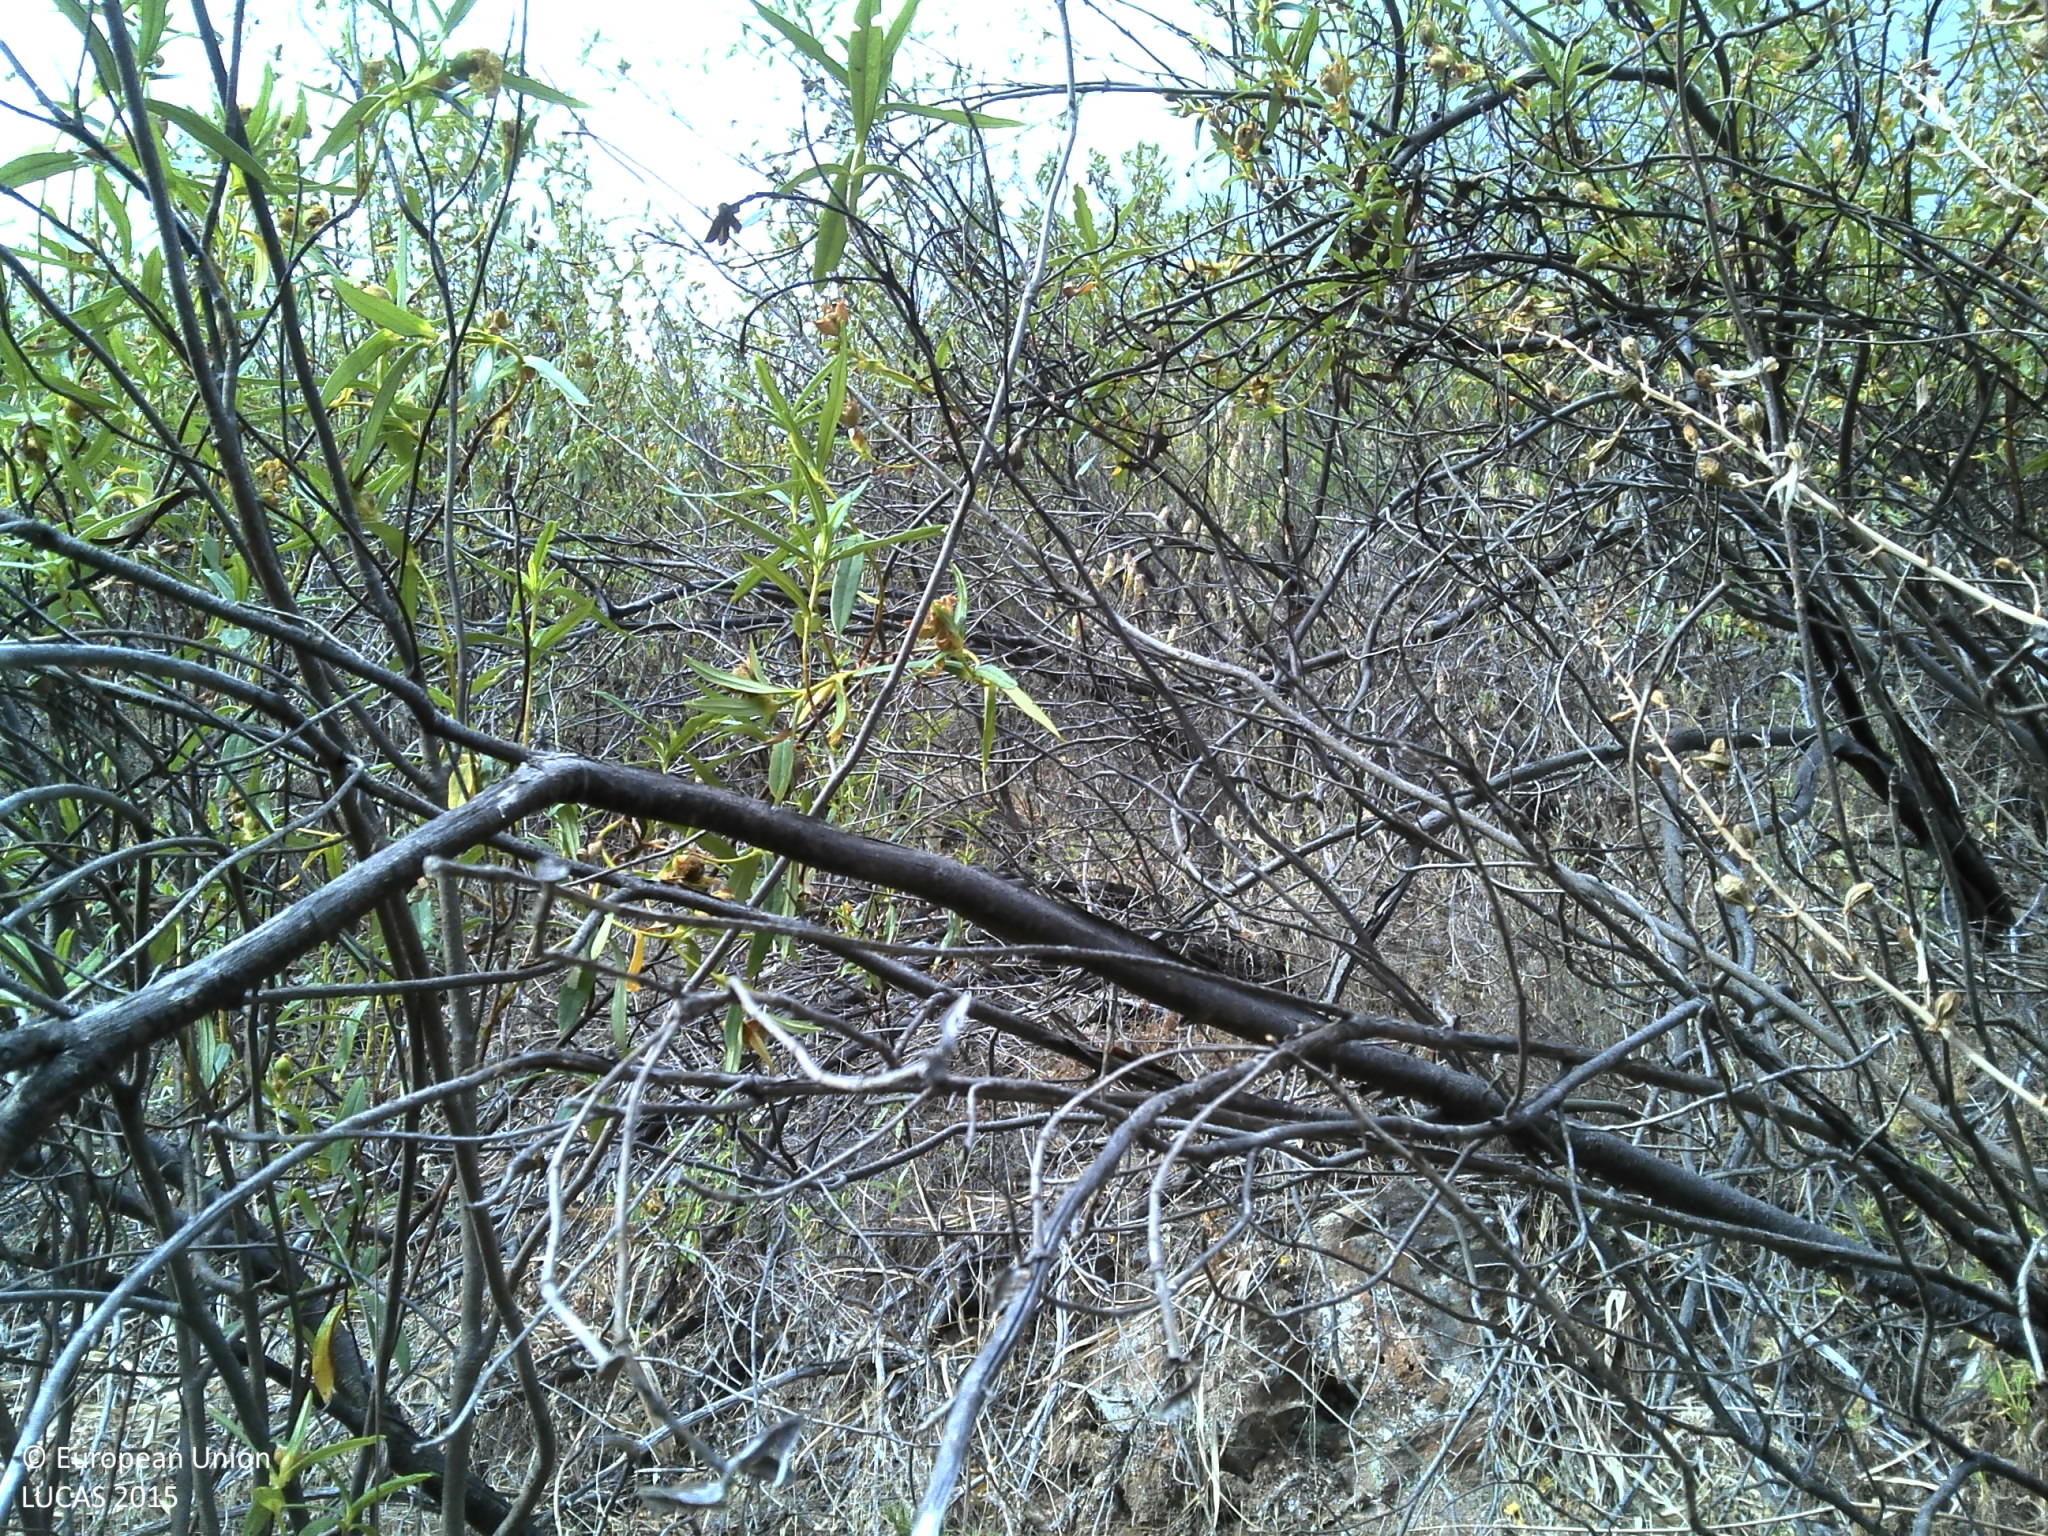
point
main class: Shrubland
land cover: Shrubland without tree cover
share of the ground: > 75 %
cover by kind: shrubs 100 %
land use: Abandoned areas
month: June
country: PT
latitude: 37.2749
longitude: -7.7038
